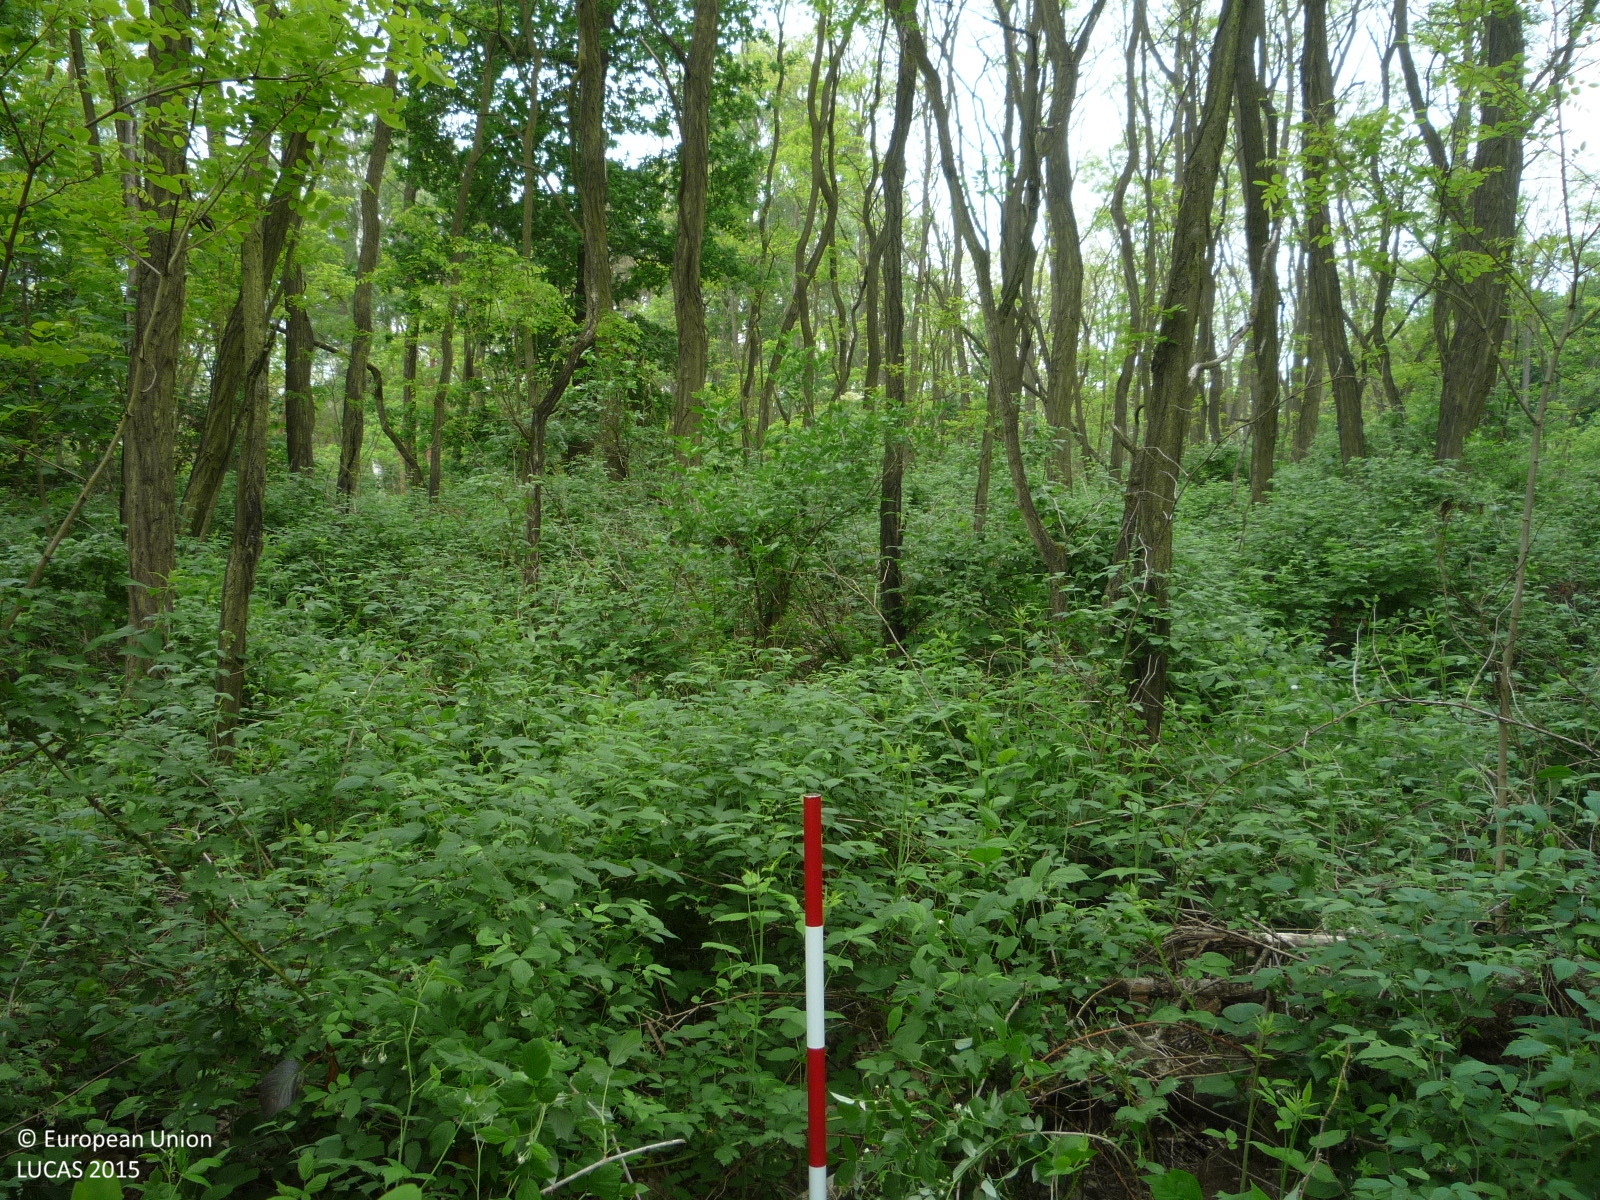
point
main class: Woodland
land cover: Broadleaved woodland
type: mesophytic deciduous forest
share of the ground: > 75 %
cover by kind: broadleaved forest trees 90 %, shrubs 10 %
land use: Forestry
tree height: > 5 m
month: May
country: CZ
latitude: 50.3841
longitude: 14.4881
